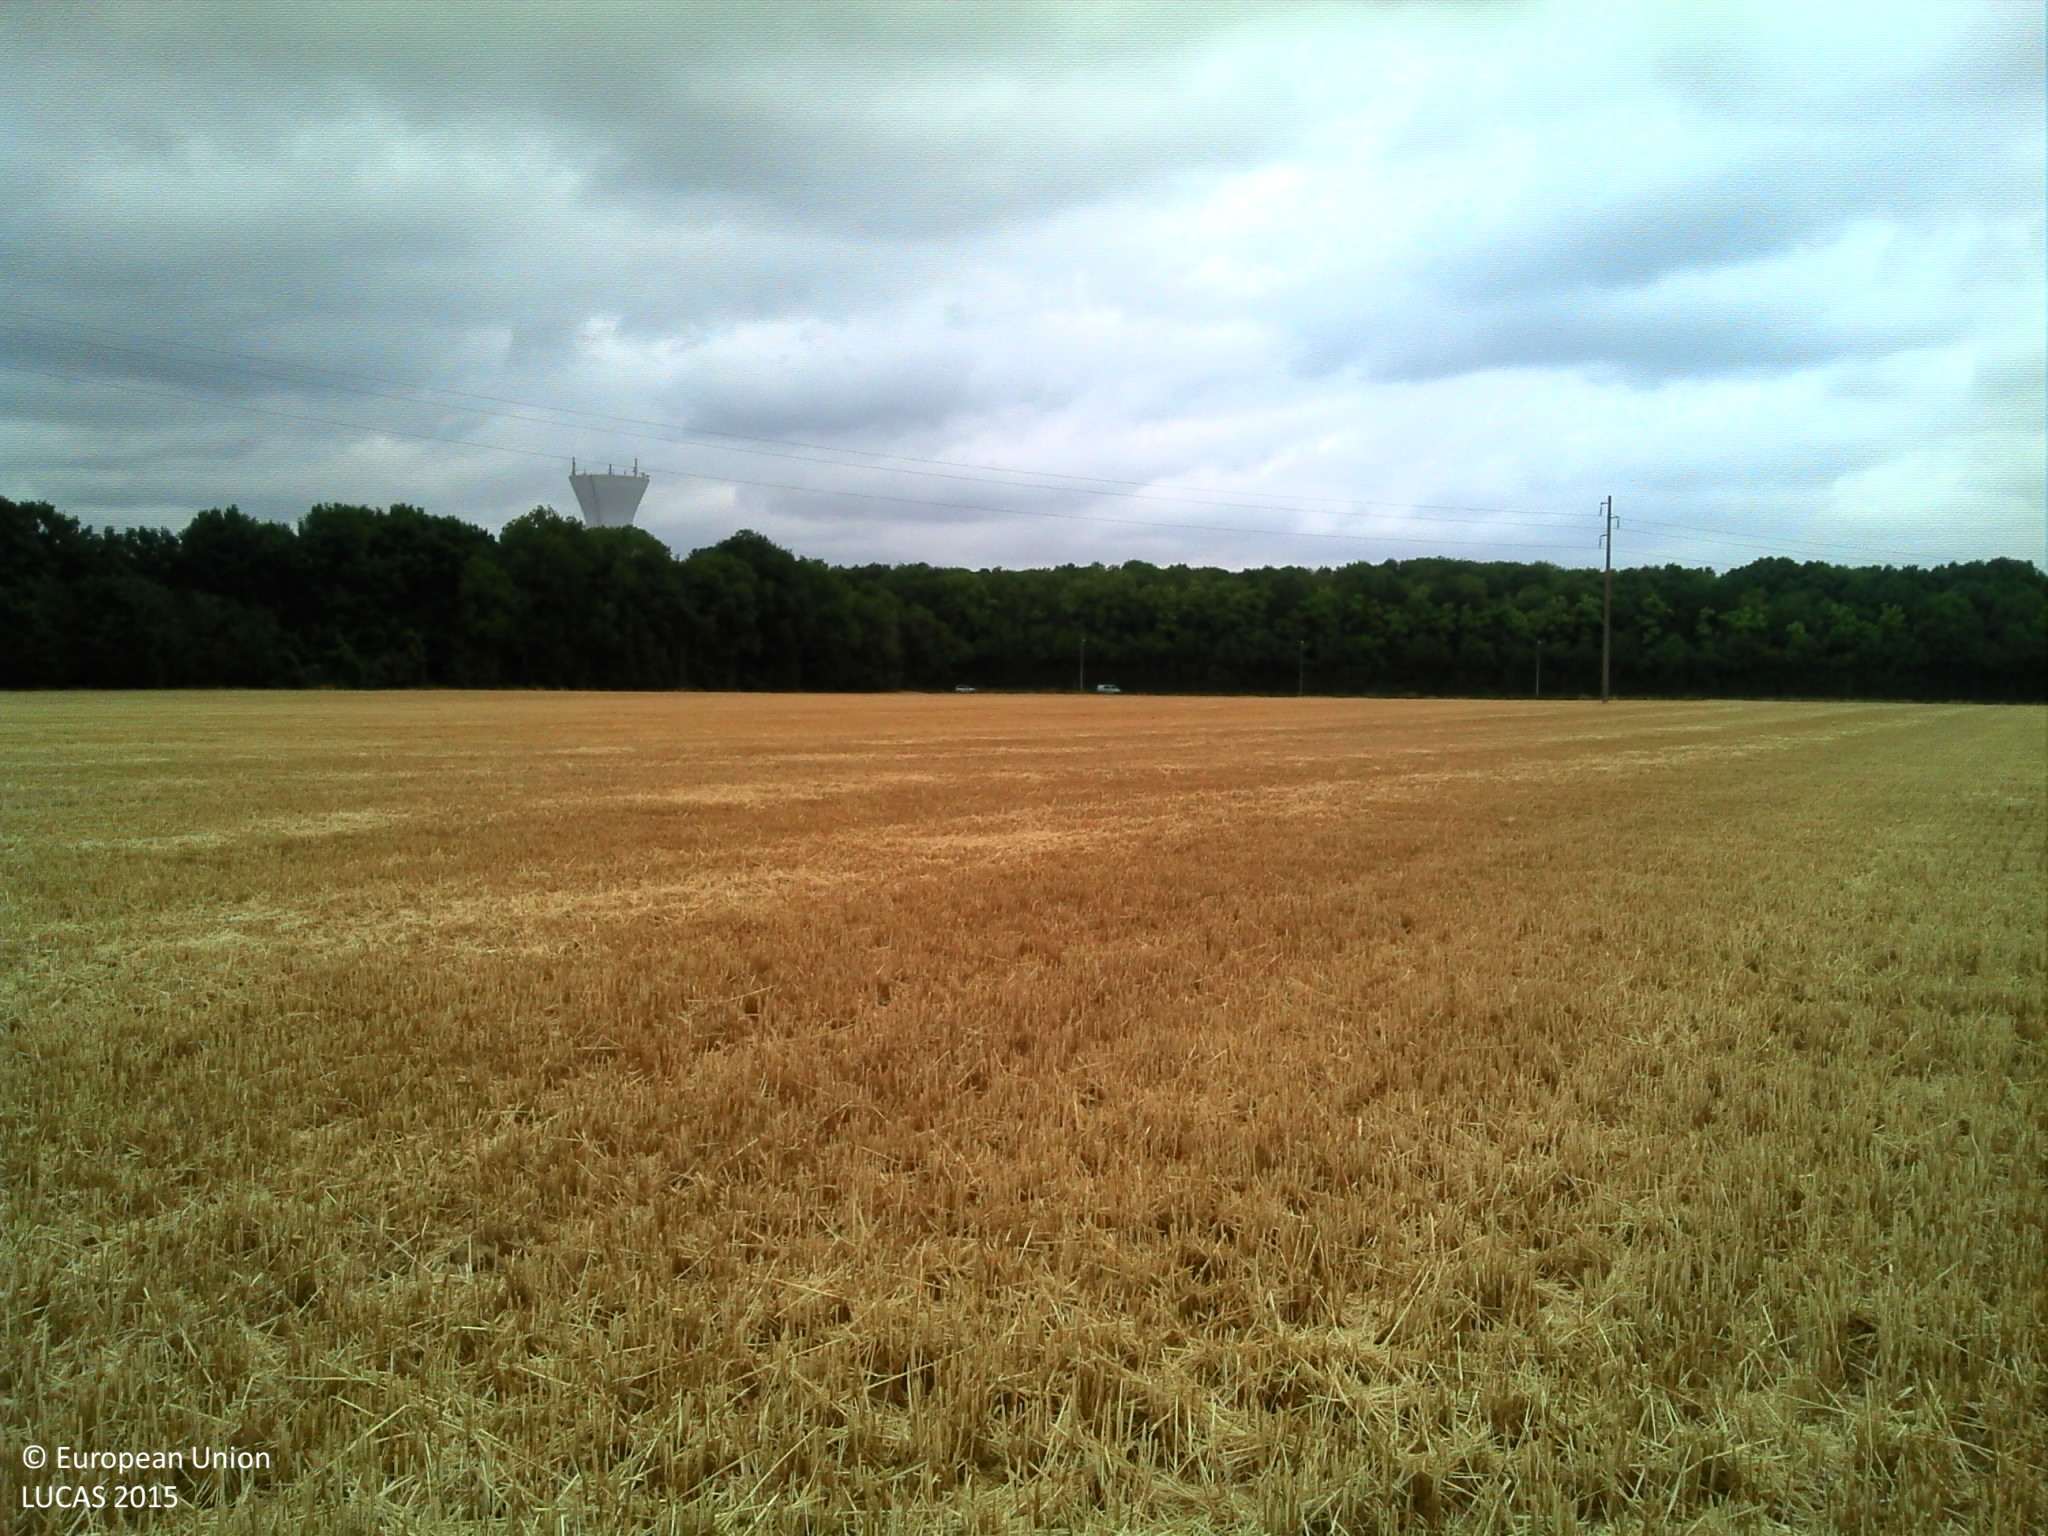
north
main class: Cropland
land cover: Common wheat
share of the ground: > 75 %
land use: Agriculture (excluding fallow land and kitchen gardens)
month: July
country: FR
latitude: 48.4978
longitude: 2.5872
